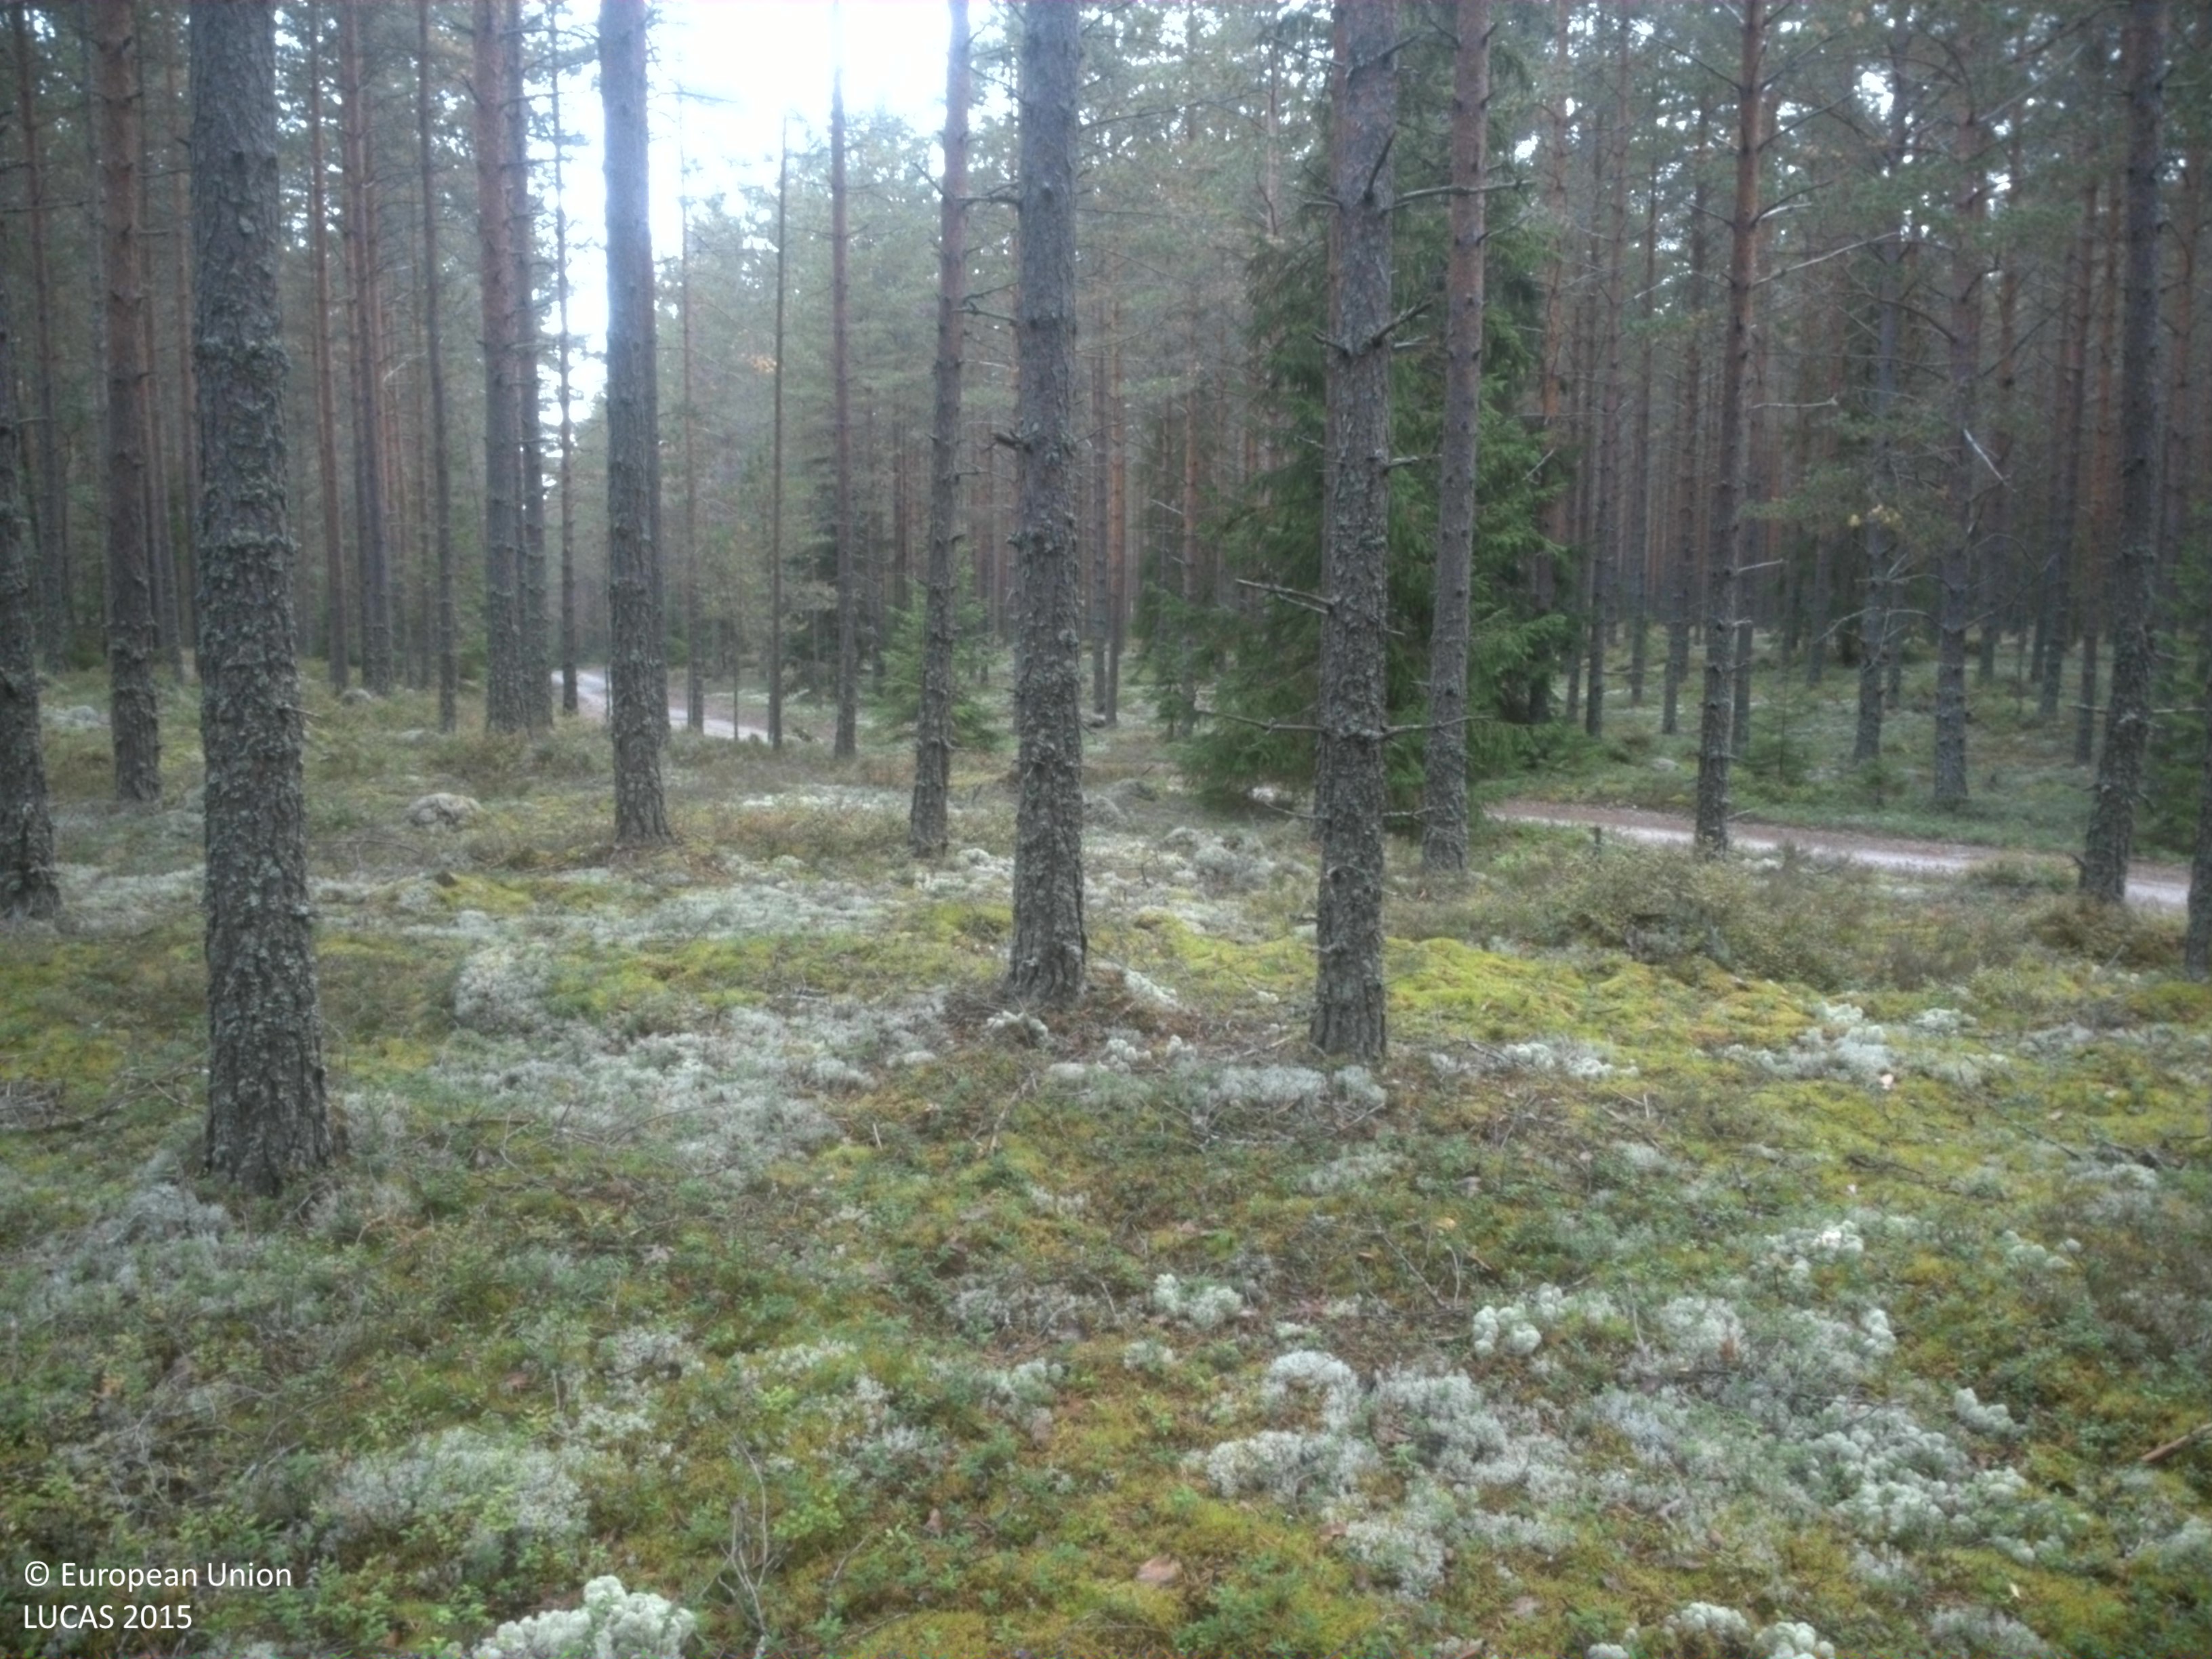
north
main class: Woodland
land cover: Pine dominated coniferous woodland
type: boreal forest
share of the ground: 50 - 75 %
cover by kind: coniferous forest trees 70 %, lichens and mosses 20 %, shrubs 10 %
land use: Forestry
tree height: > 5 m
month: September
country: SE
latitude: 59.8028
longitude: 15.4978
